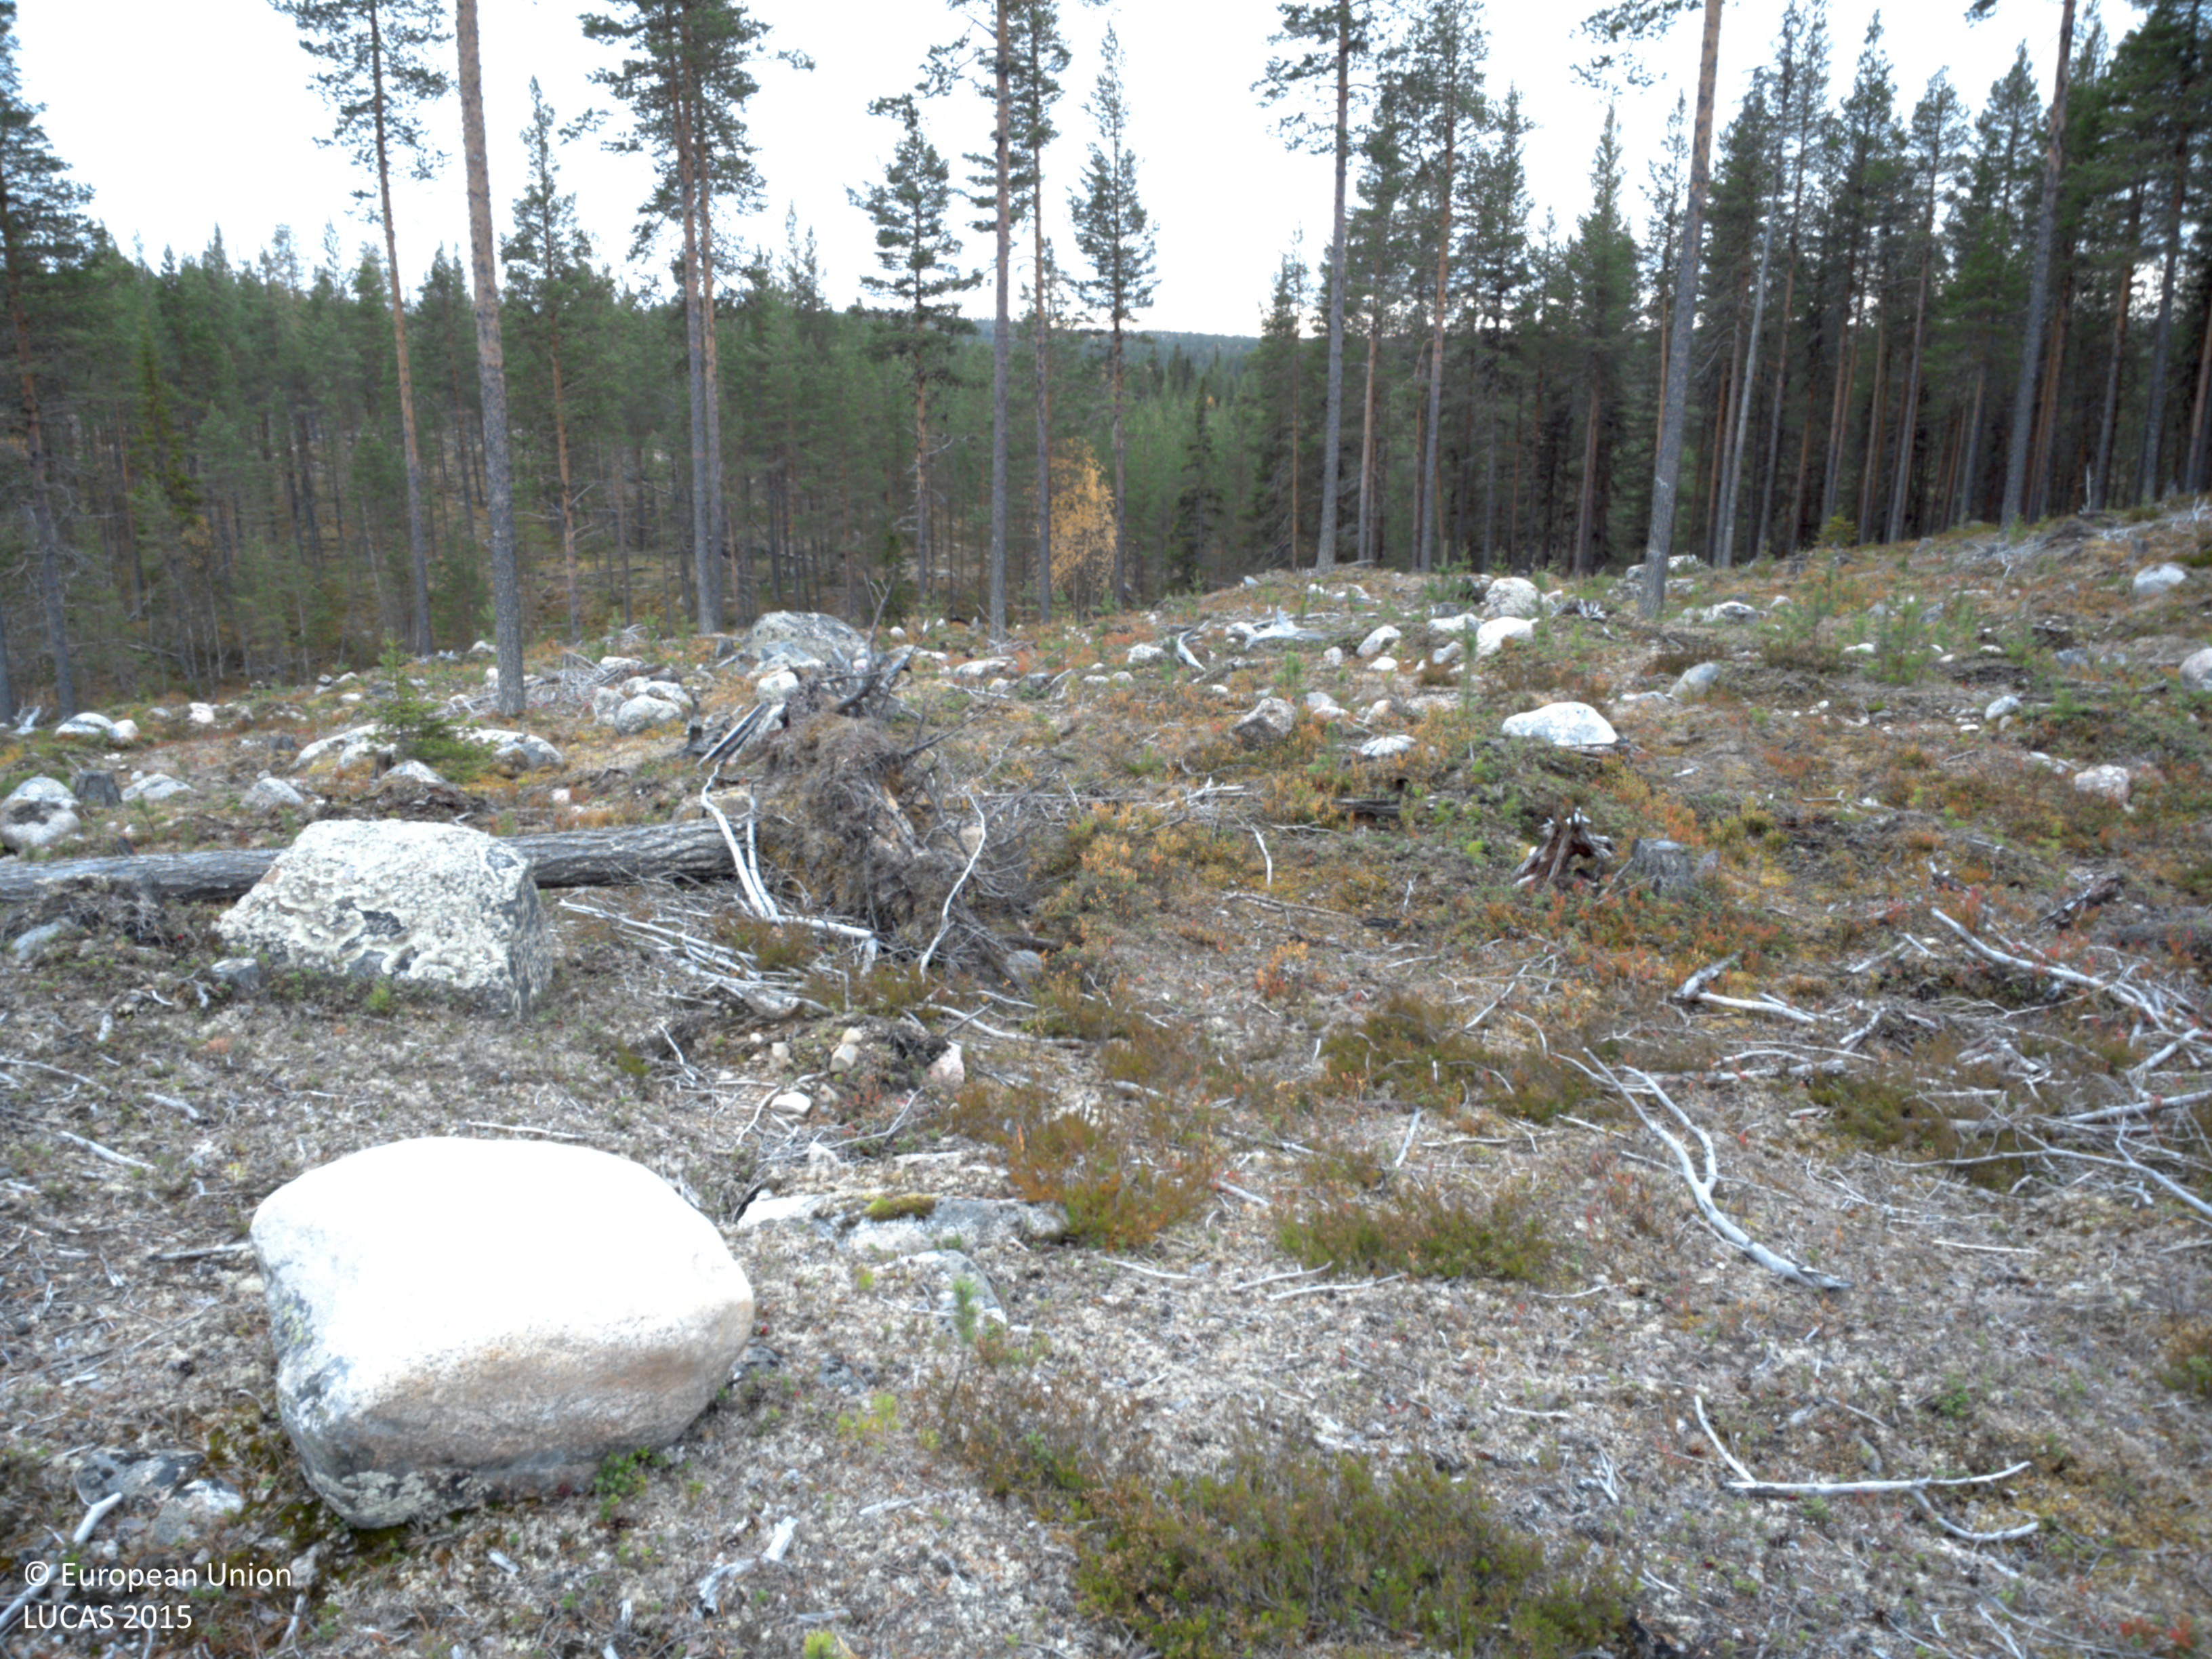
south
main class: Shrubland
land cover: Shrubland with sparse tree cover
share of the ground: 25 - 50 %
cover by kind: shrubs 35 %, consolidated bare surface 20 %, lichens and mosses 10 %, coniferous forest trees 5 %, herbaceous plants 5 %
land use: Forestry
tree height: > 5 m
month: October
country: SE
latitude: 65.0168
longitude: 18.3033
